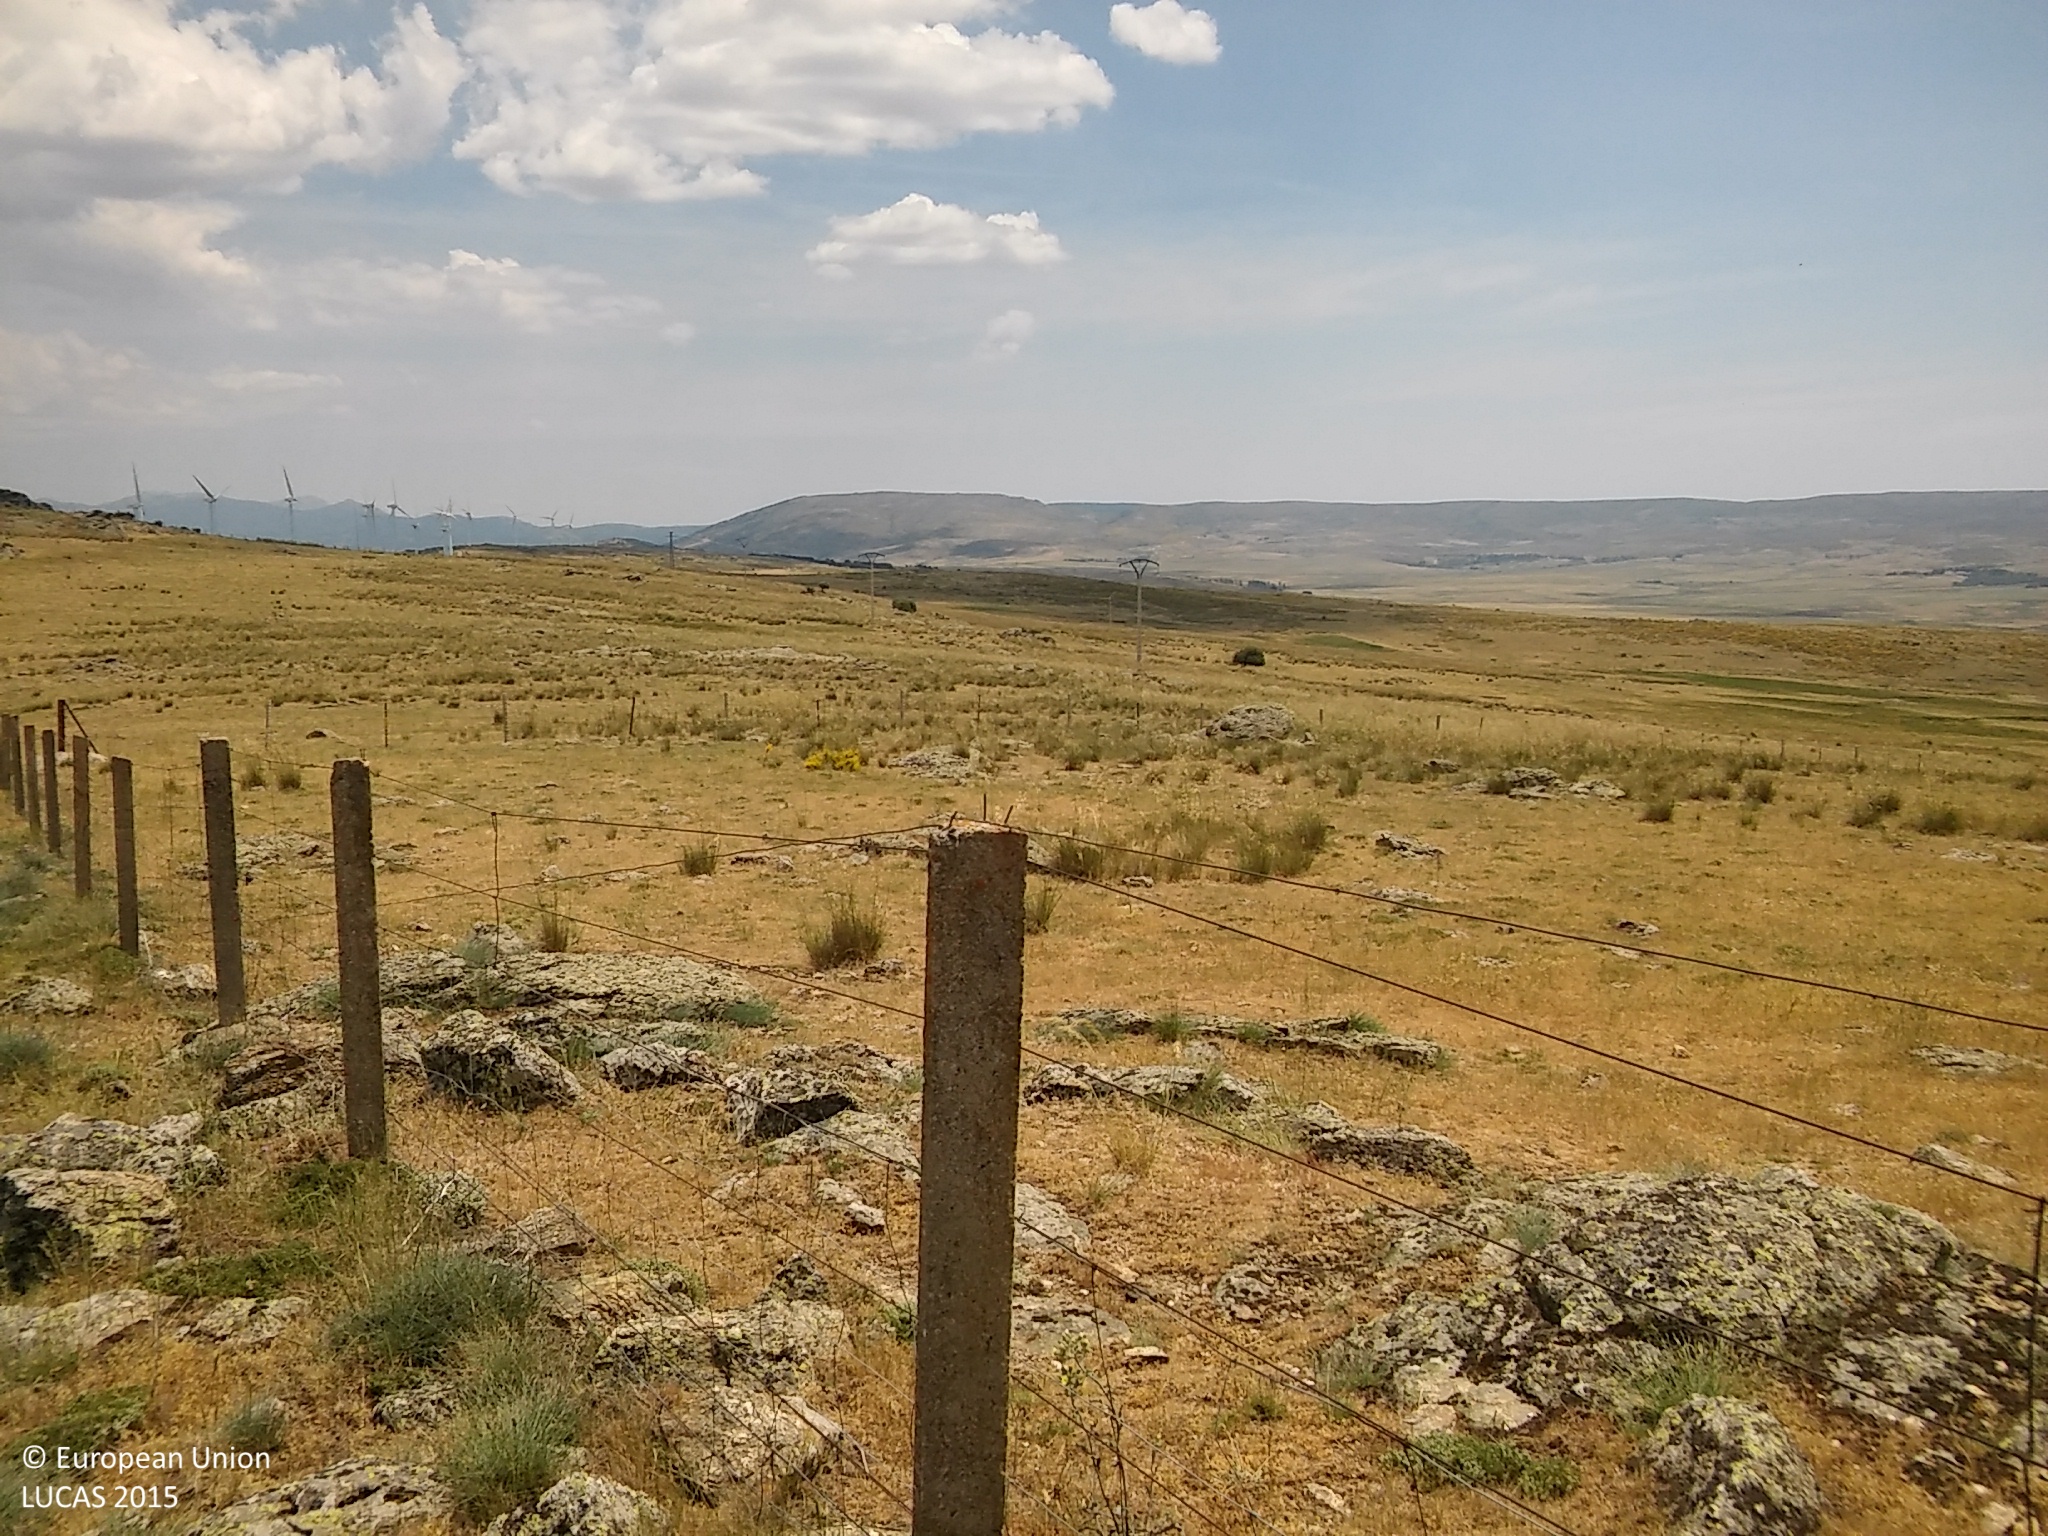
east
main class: Grassland
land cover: Grassland without tree/shrub cover
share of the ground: > 75 %
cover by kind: herbaceous plants 90 %, shrubs 5 %, consolidated bare surface 5 %
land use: Agriculture (excluding fallow land and kitchen gardens)
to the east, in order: Grassland without tree/shrub cover; Rock outcrops; Grassland without tree/shrub cover; Rock outcrops; Grassland without tree/shrub cover; Rock outcrops; Grassland without tree/shrub cover; Rock outcrops
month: June
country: ES
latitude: 40.7159
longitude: -4.4350
